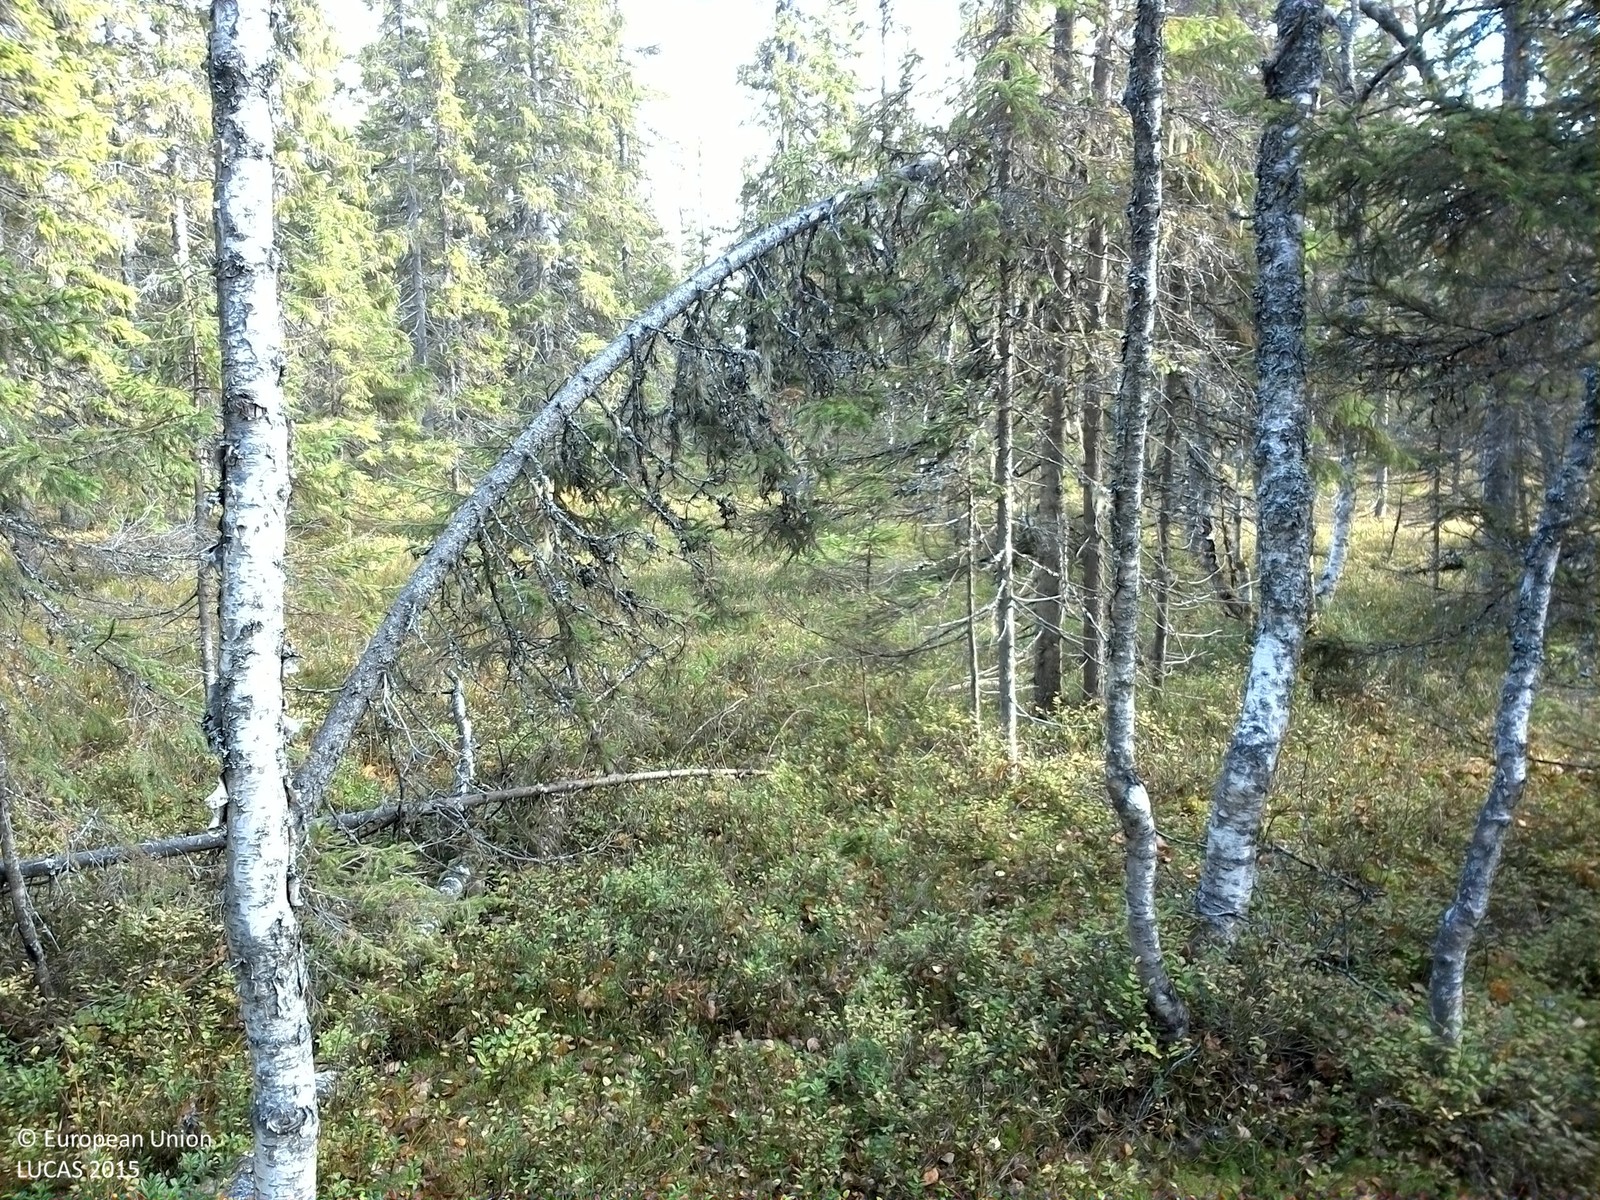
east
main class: Woodland
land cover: Spruce dominated mixed woodland
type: boreal forest
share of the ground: 25 - 50 %
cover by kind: coniferous forest trees 30 %, shrubs 30 %, lichens and mosses 25 %, broadleaved forest trees 15 %
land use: Forestry
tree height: > 5 m
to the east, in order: Spruce dominated mixed woodland; Other mixed woodland
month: October
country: SE
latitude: 61.3779
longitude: 14.8692
